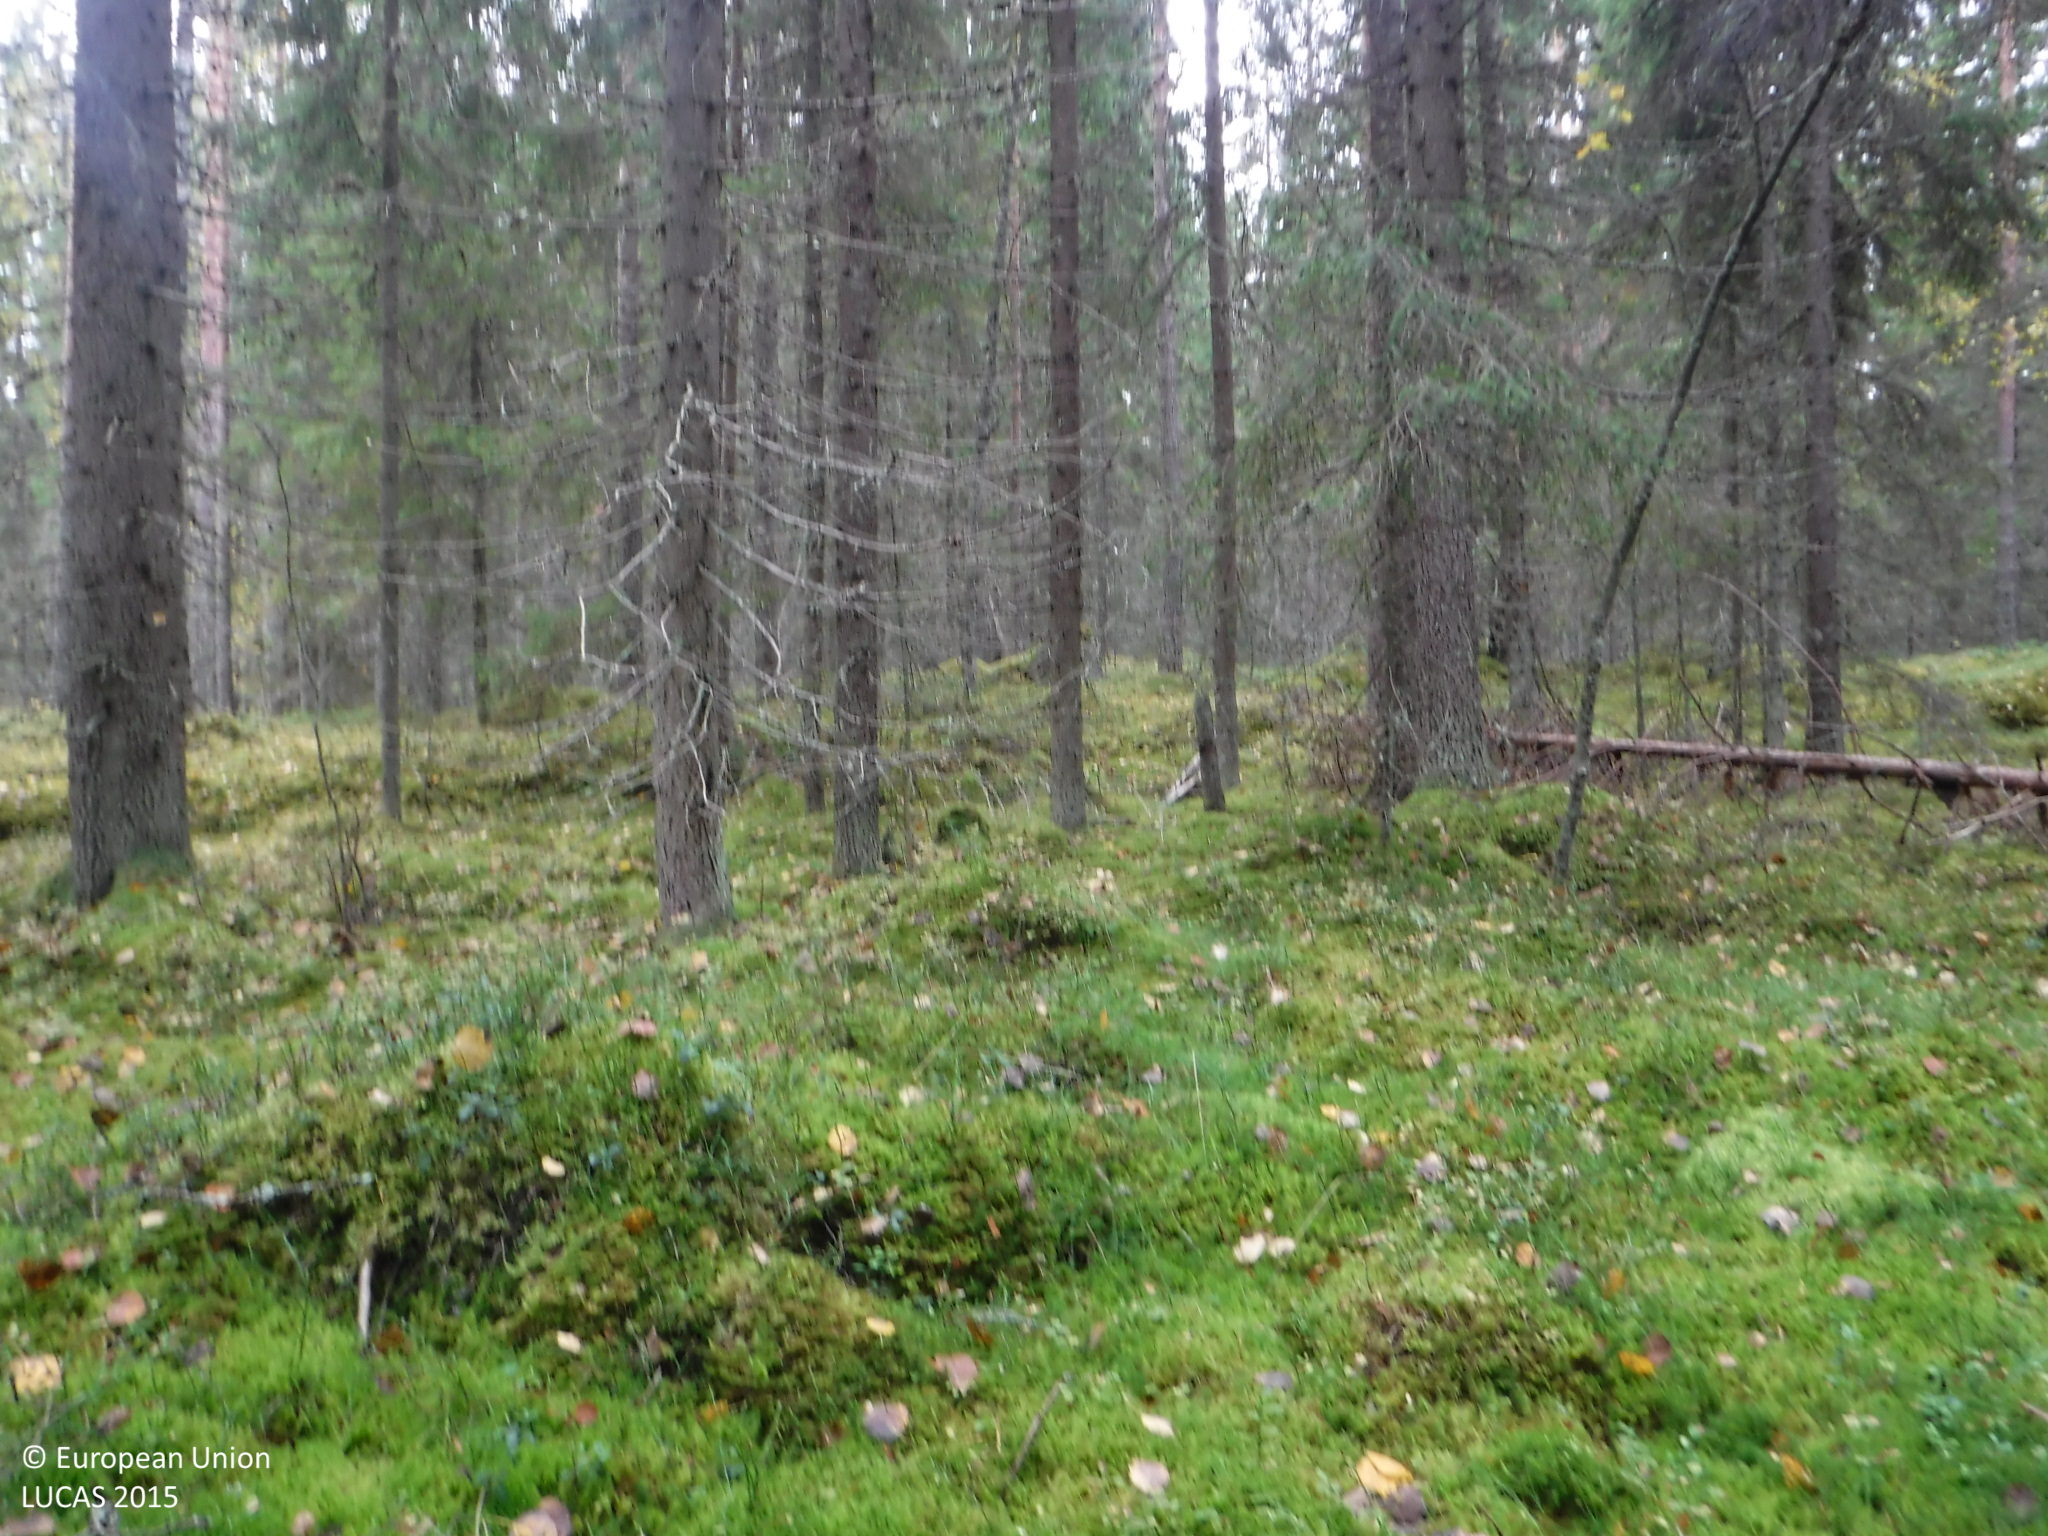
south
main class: Woodland
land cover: Spruce dominated coniferous woodland
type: boreal forest
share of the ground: 50 - 75 %
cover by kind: coniferous forest trees 60 %, lichens and mosses 30 %, shrubs 10 %
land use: Forestry
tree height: > 5 m
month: September
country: FI
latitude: 61.5963
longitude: 23.8992
